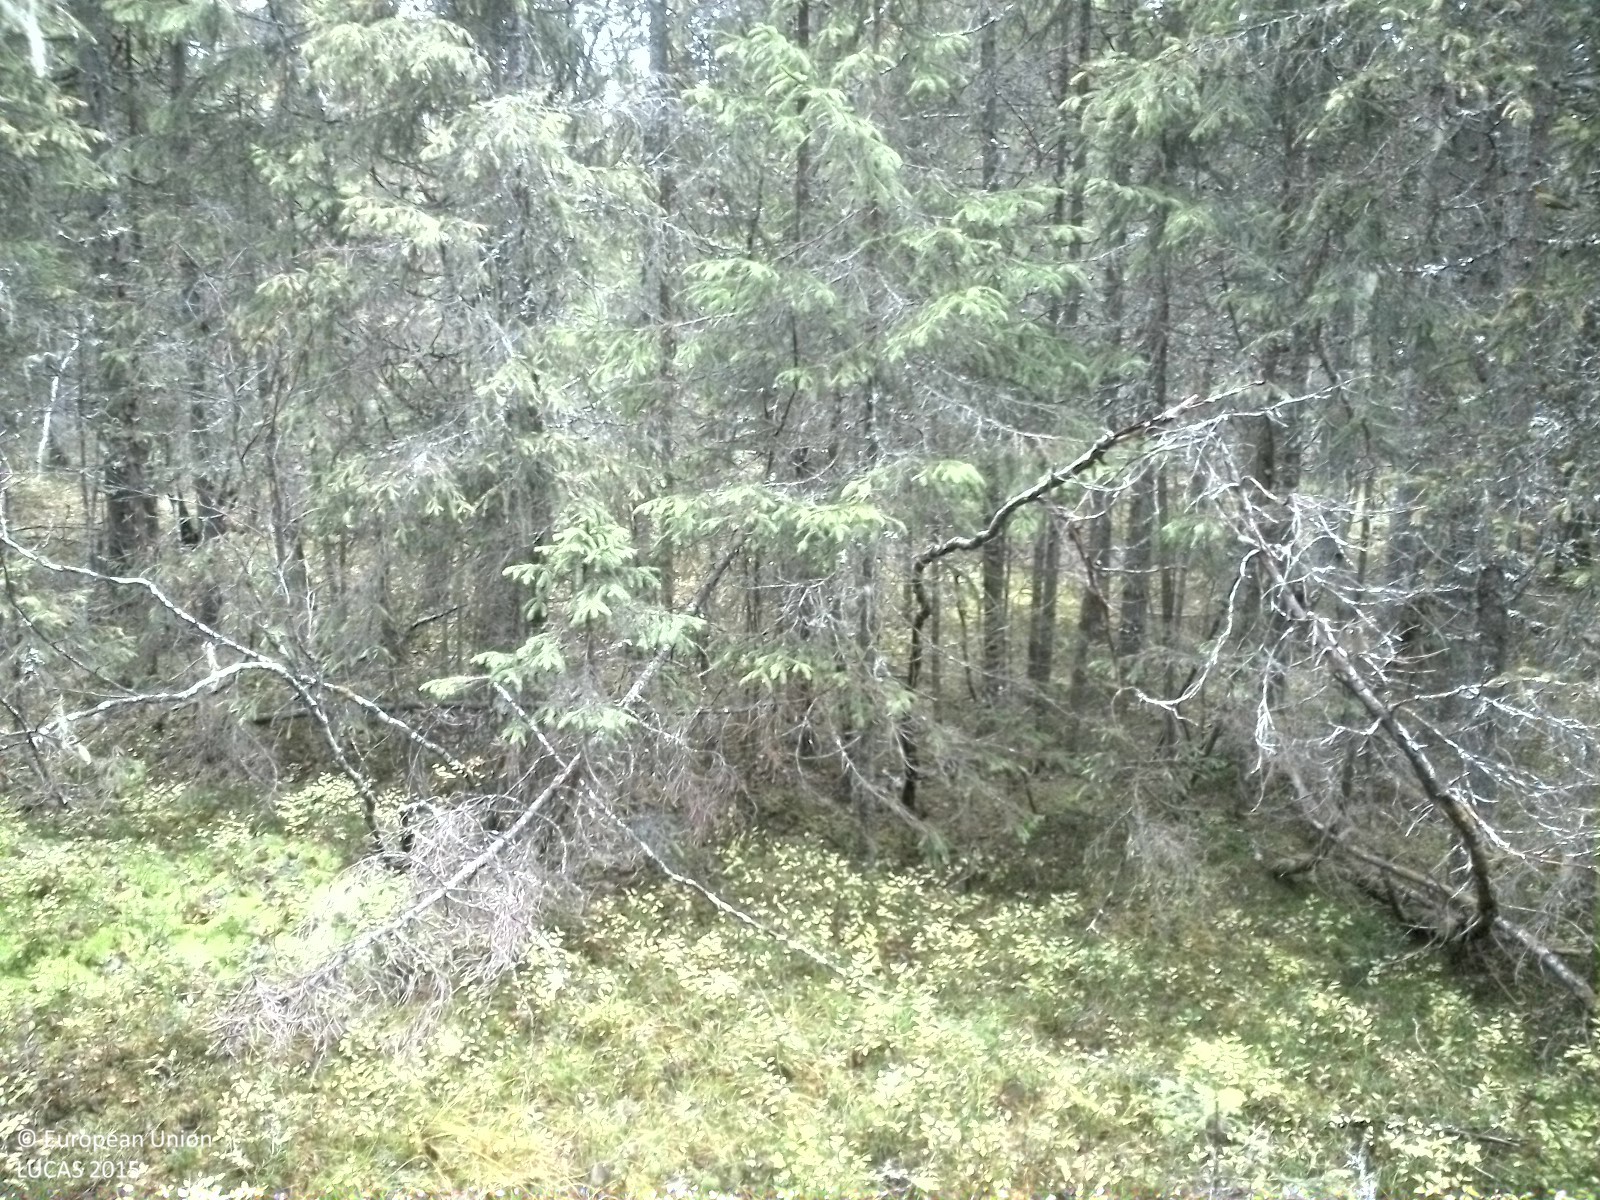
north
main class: Woodland
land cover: Spruce dominated coniferous woodland
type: boreal forest
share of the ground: > 75 %
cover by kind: coniferous forest trees 90 %, shrubs 10 %
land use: Forestry
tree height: > 5 m
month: October
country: SE
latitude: 63.5240
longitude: 14.9824
